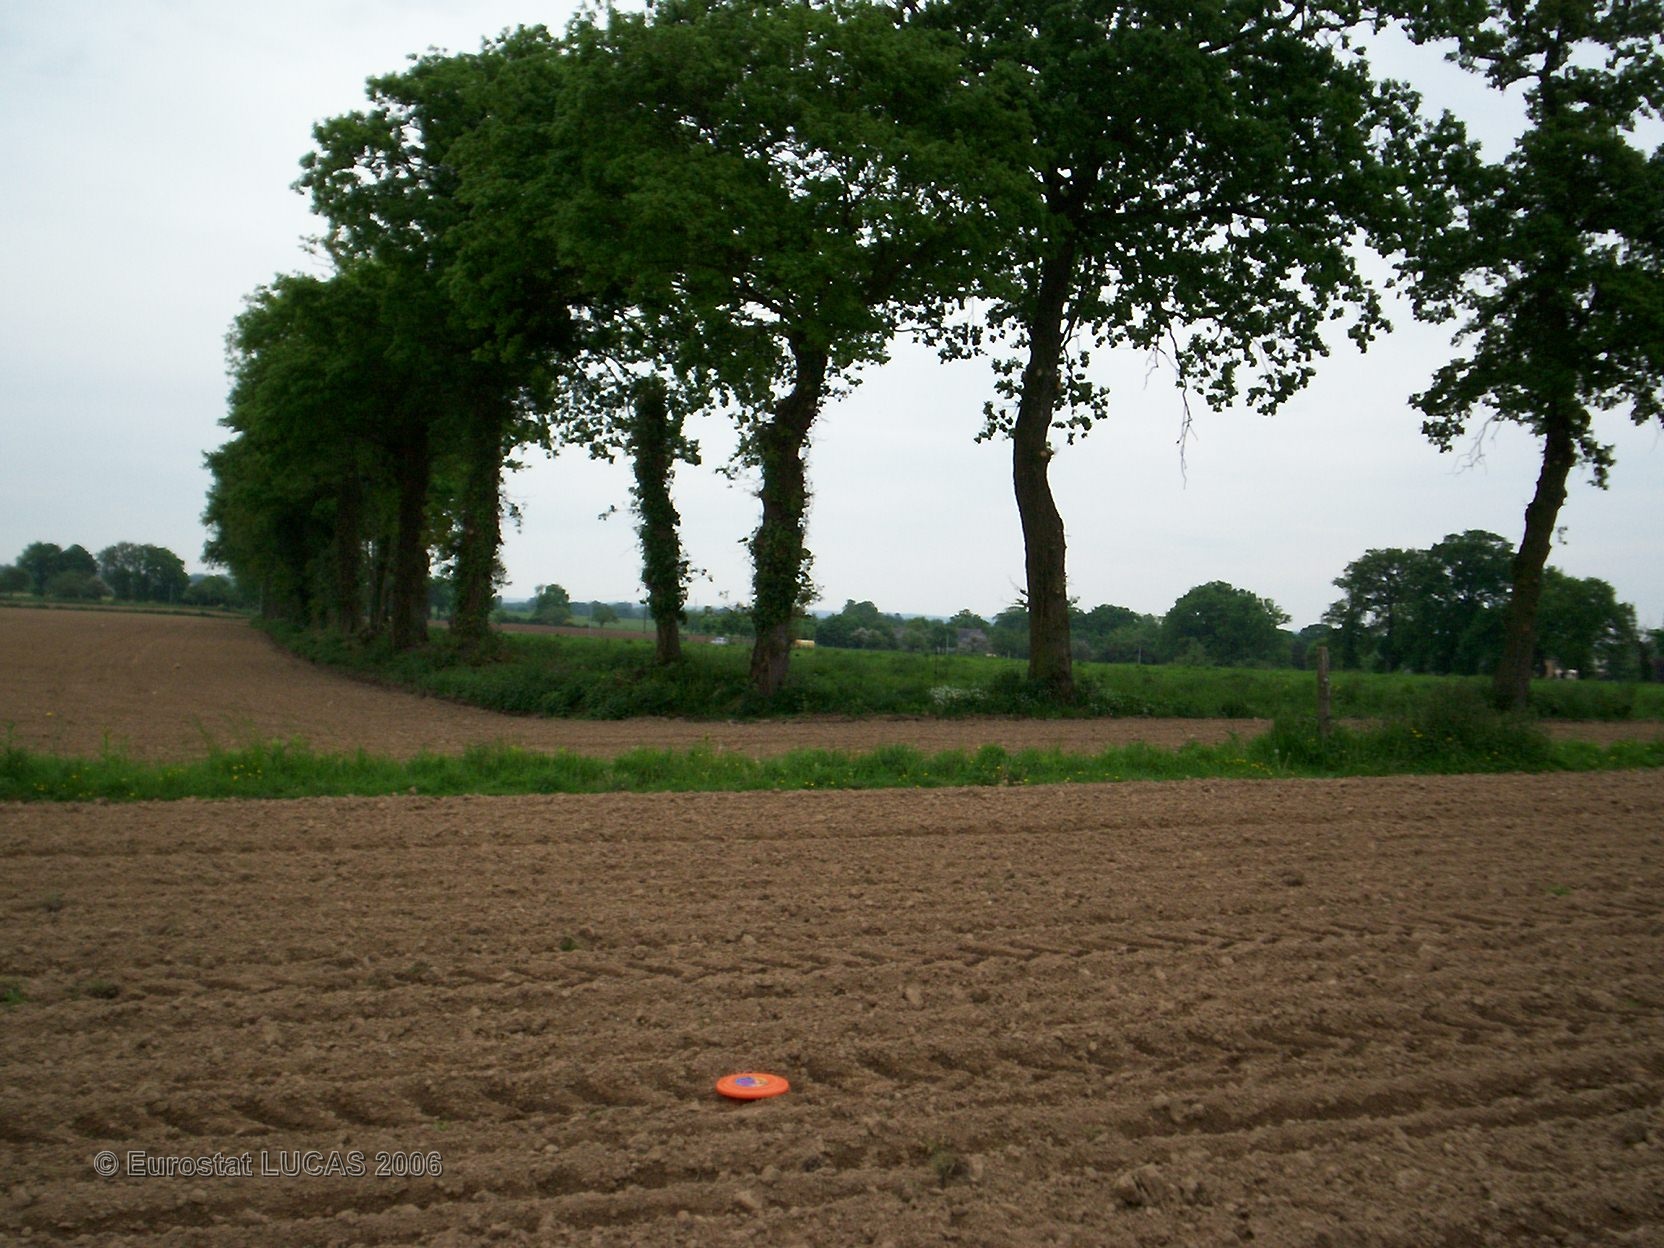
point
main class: Cropland
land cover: Maize
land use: Agriculture (excluding fallow land and kitchen gardens)
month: May
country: FR
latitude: 48.2584
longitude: -1.6457
